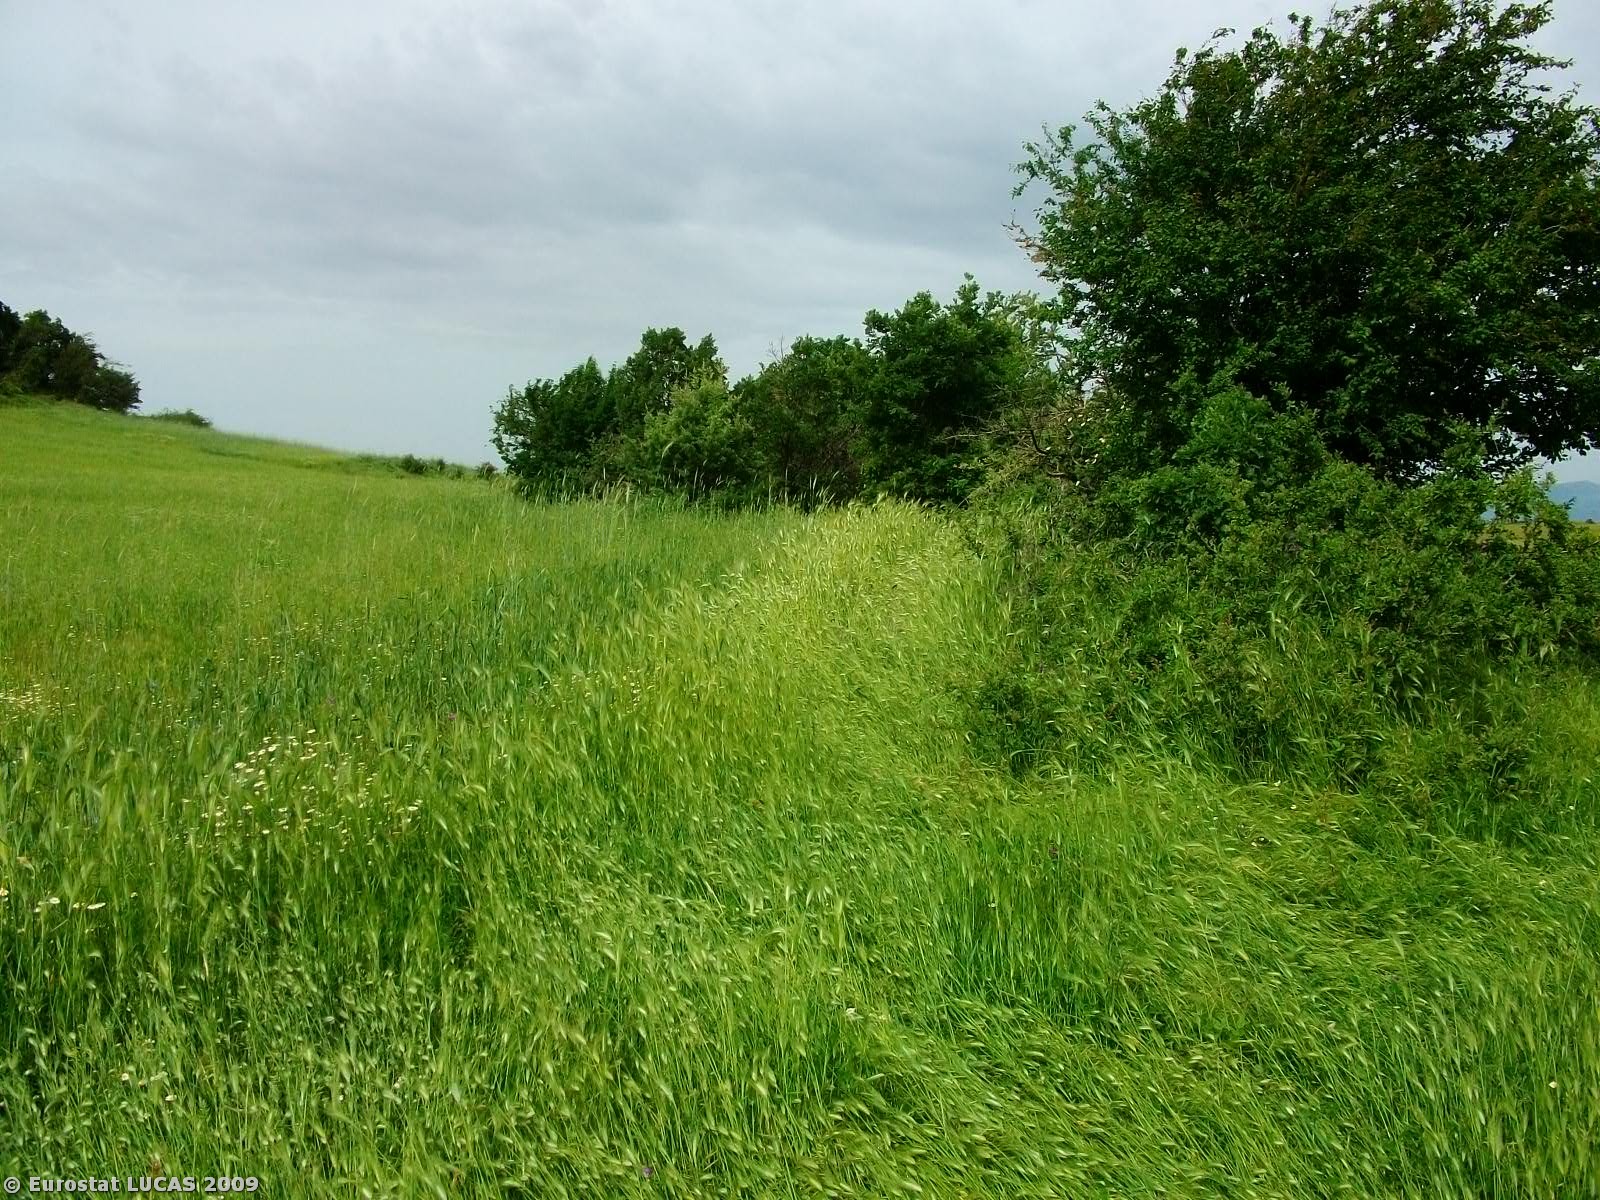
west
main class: Cropland
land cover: Barley
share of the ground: > 75 %
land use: Agriculture (excluding fallow land and kitchen gardens)
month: May
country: GR
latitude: 40.7128
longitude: 21.8697
